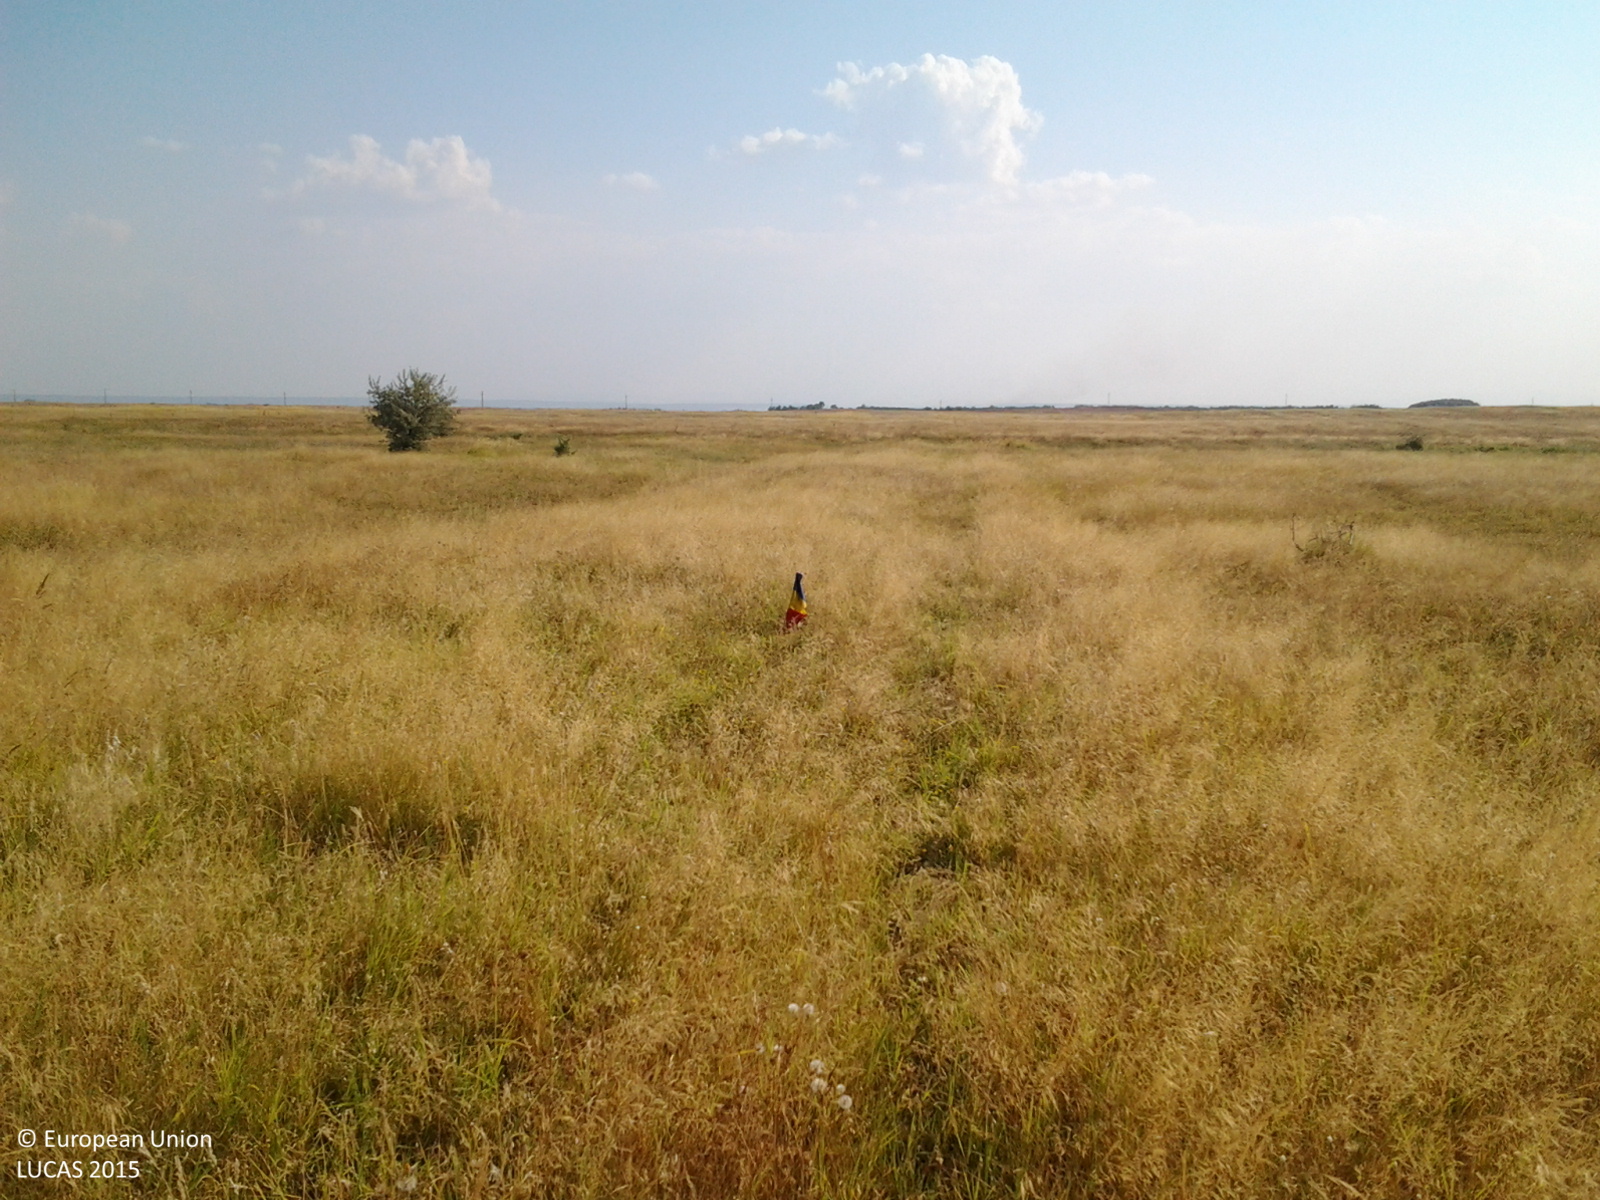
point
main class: Grassland
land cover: Spontaneously vegetated surfaces
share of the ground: > 75 %
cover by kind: herbaceous plants 100 %
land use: Fallow land
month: August
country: RO
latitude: 43.9117
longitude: 23.0037
